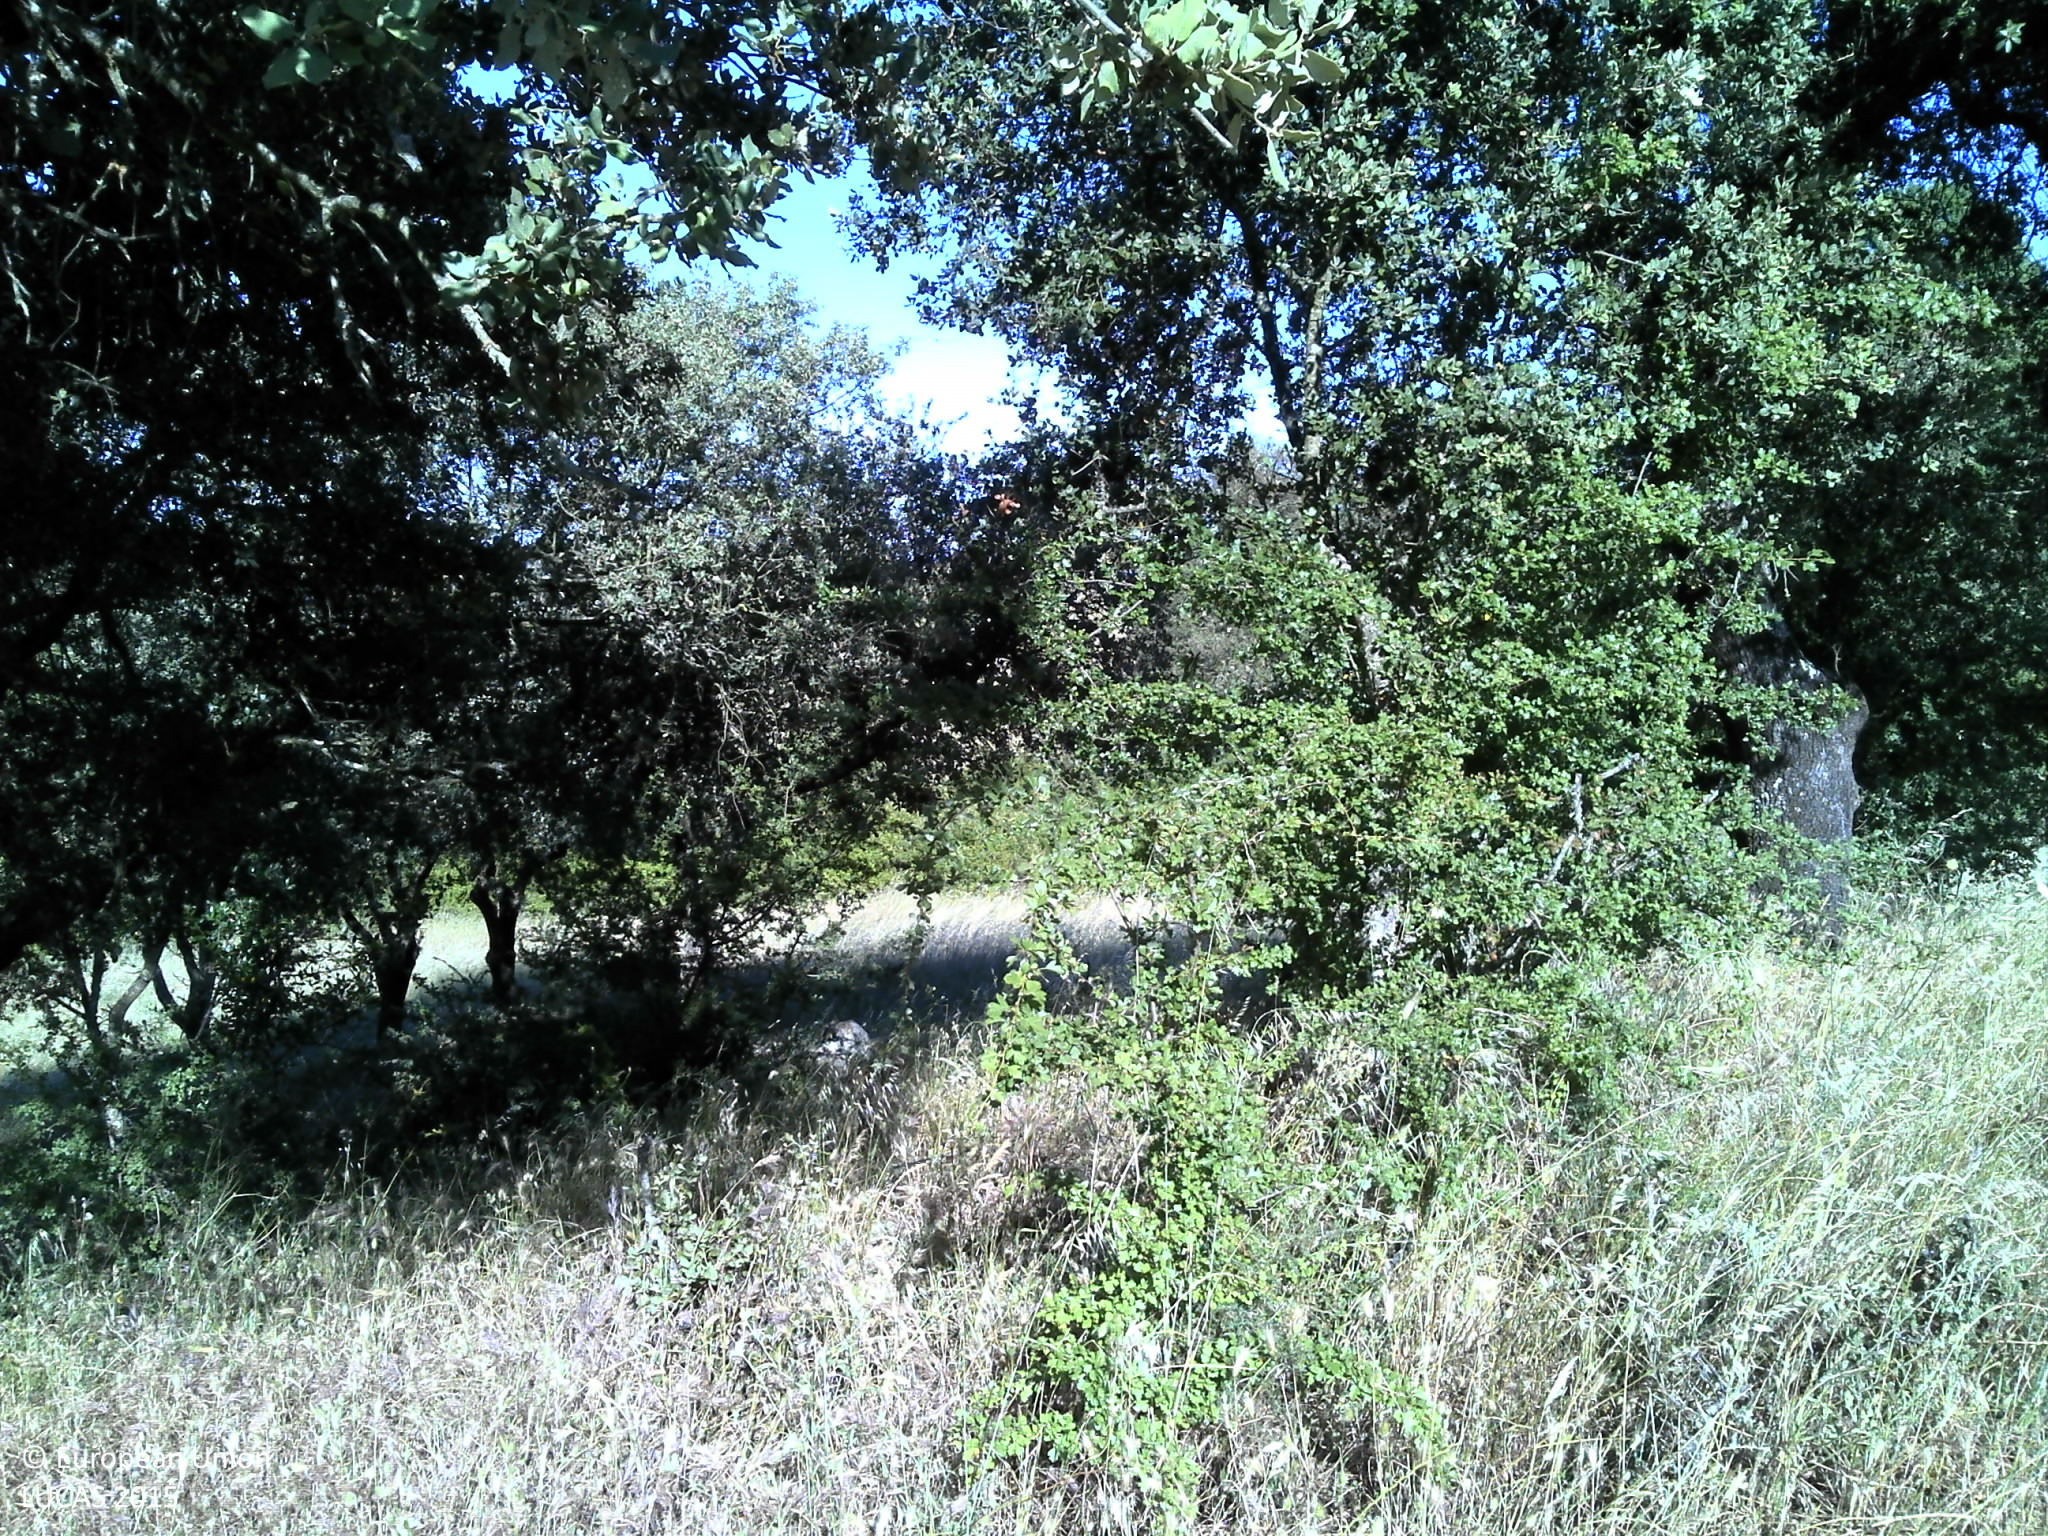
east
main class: Woodland
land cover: Broadleaved woodland
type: broadleaved evergreen forest
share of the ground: 10 - 25 %
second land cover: Grassland without tree/shrub cover
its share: 10 - 25 %
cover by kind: unconsolidated bare surface 50 %, herbaceous plants 30 %, broadleaved forest trees 15 %, shrubs 5 %
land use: Forestry
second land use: Agriculture (excluding fallow land and kitchen gardens)
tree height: > 5 m
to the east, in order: Broadleaved woodland; Grassland without tree/shrub cover; Broadleaved woodland; Shrubland without tree cover; Rivers and streams; Shrubland without tree cover; Grassland without tree/shrub cover; Broadleaved woodland; Shrubland without tree cover; Grassland without tree/shrub cover; Shrubland without tree cover; Grassland with sparse tree/shrub cover
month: May
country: PT
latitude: 39.2446
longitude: -7.6459
